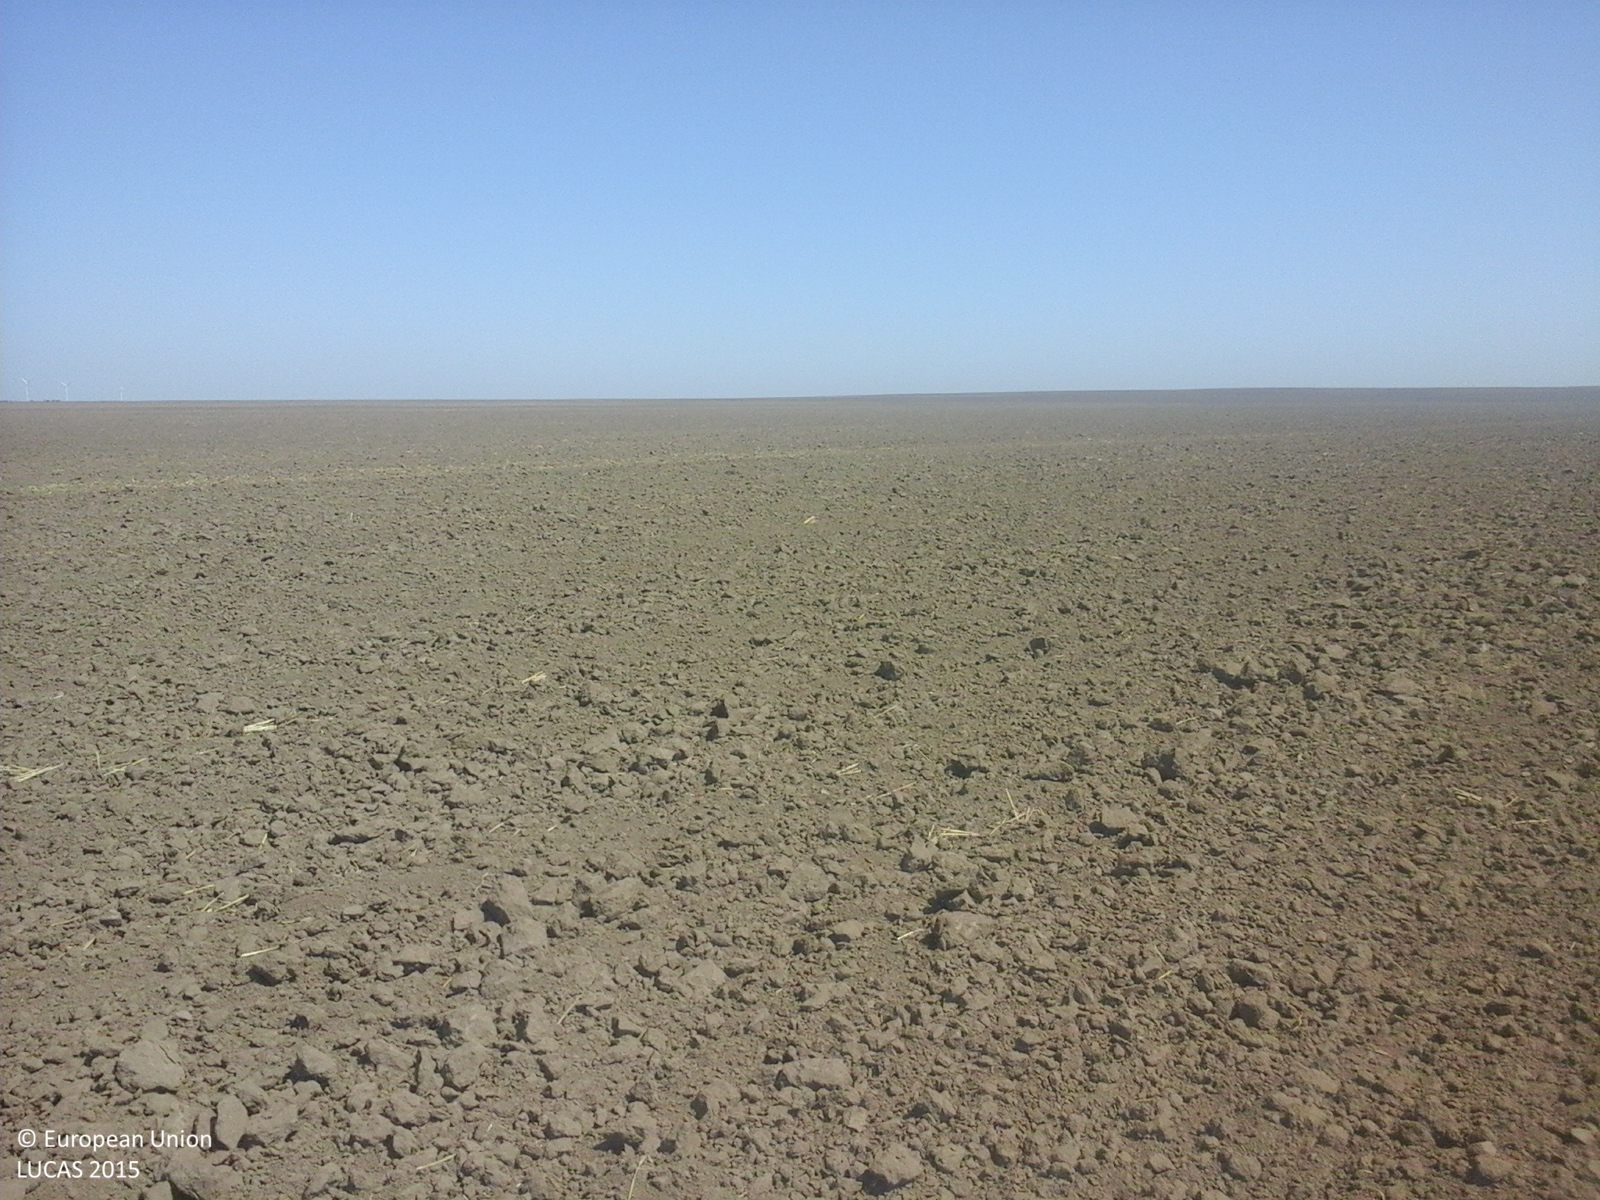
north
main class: Cropland
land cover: Barley
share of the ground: < 10 %
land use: Agriculture (excluding fallow land and kitchen gardens)
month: August
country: RO
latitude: 44.6159
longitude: 28.1468
